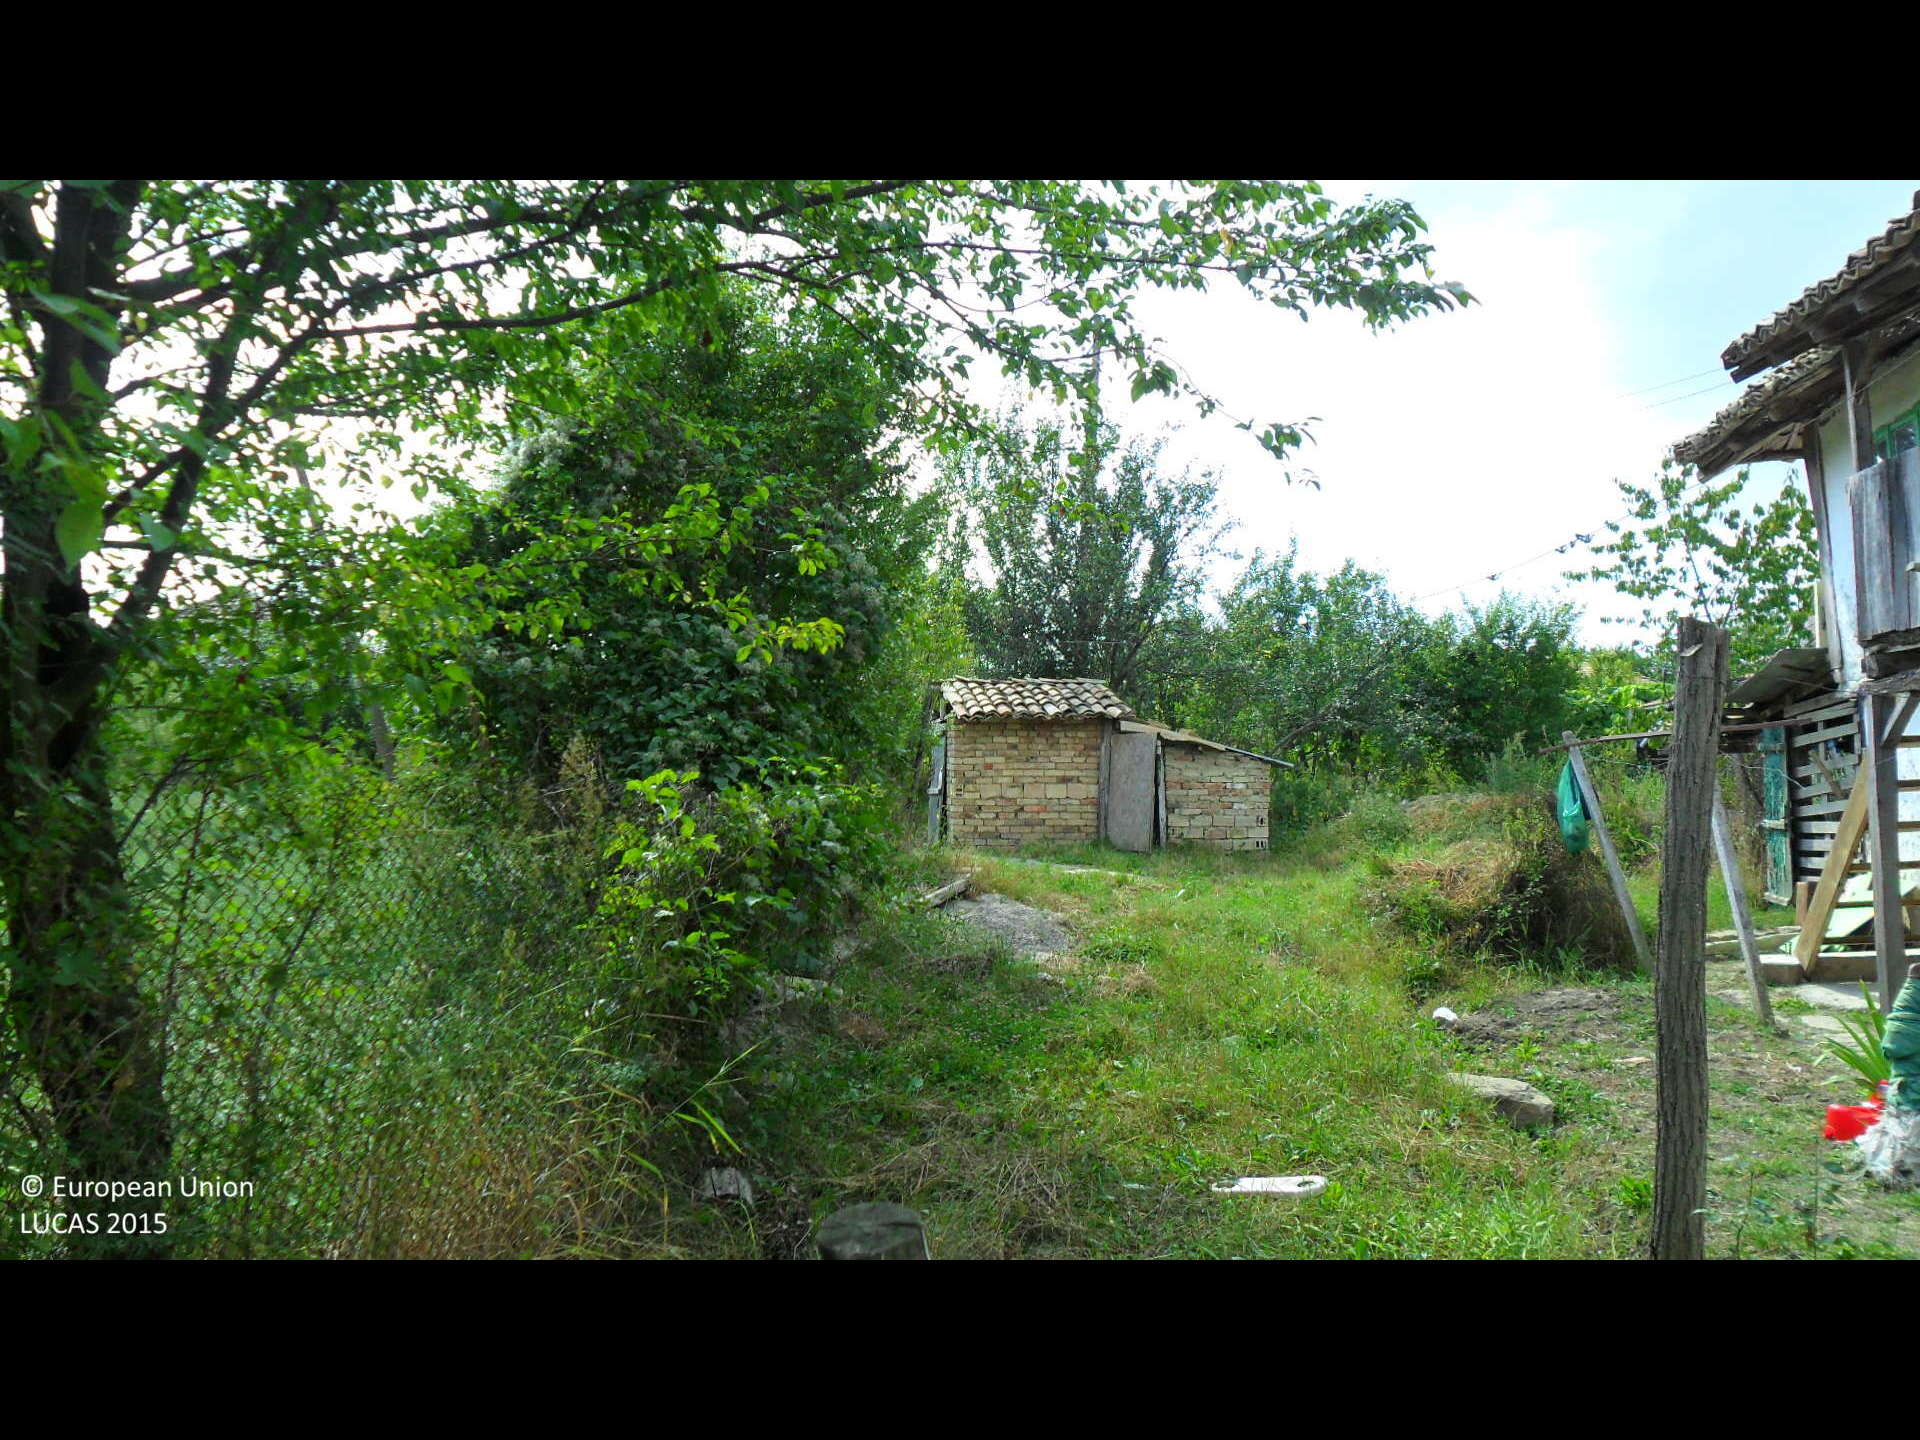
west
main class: Grassland
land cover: Grassland with sparse tree/shrub cover
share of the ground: > 75 %
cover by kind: herbaceous plants 90 %, broadleaved forest trees 5 %, shrubs 5 %
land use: Residential
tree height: < 5 m
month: August
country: BG
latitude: 43.3088
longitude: 26.4110
